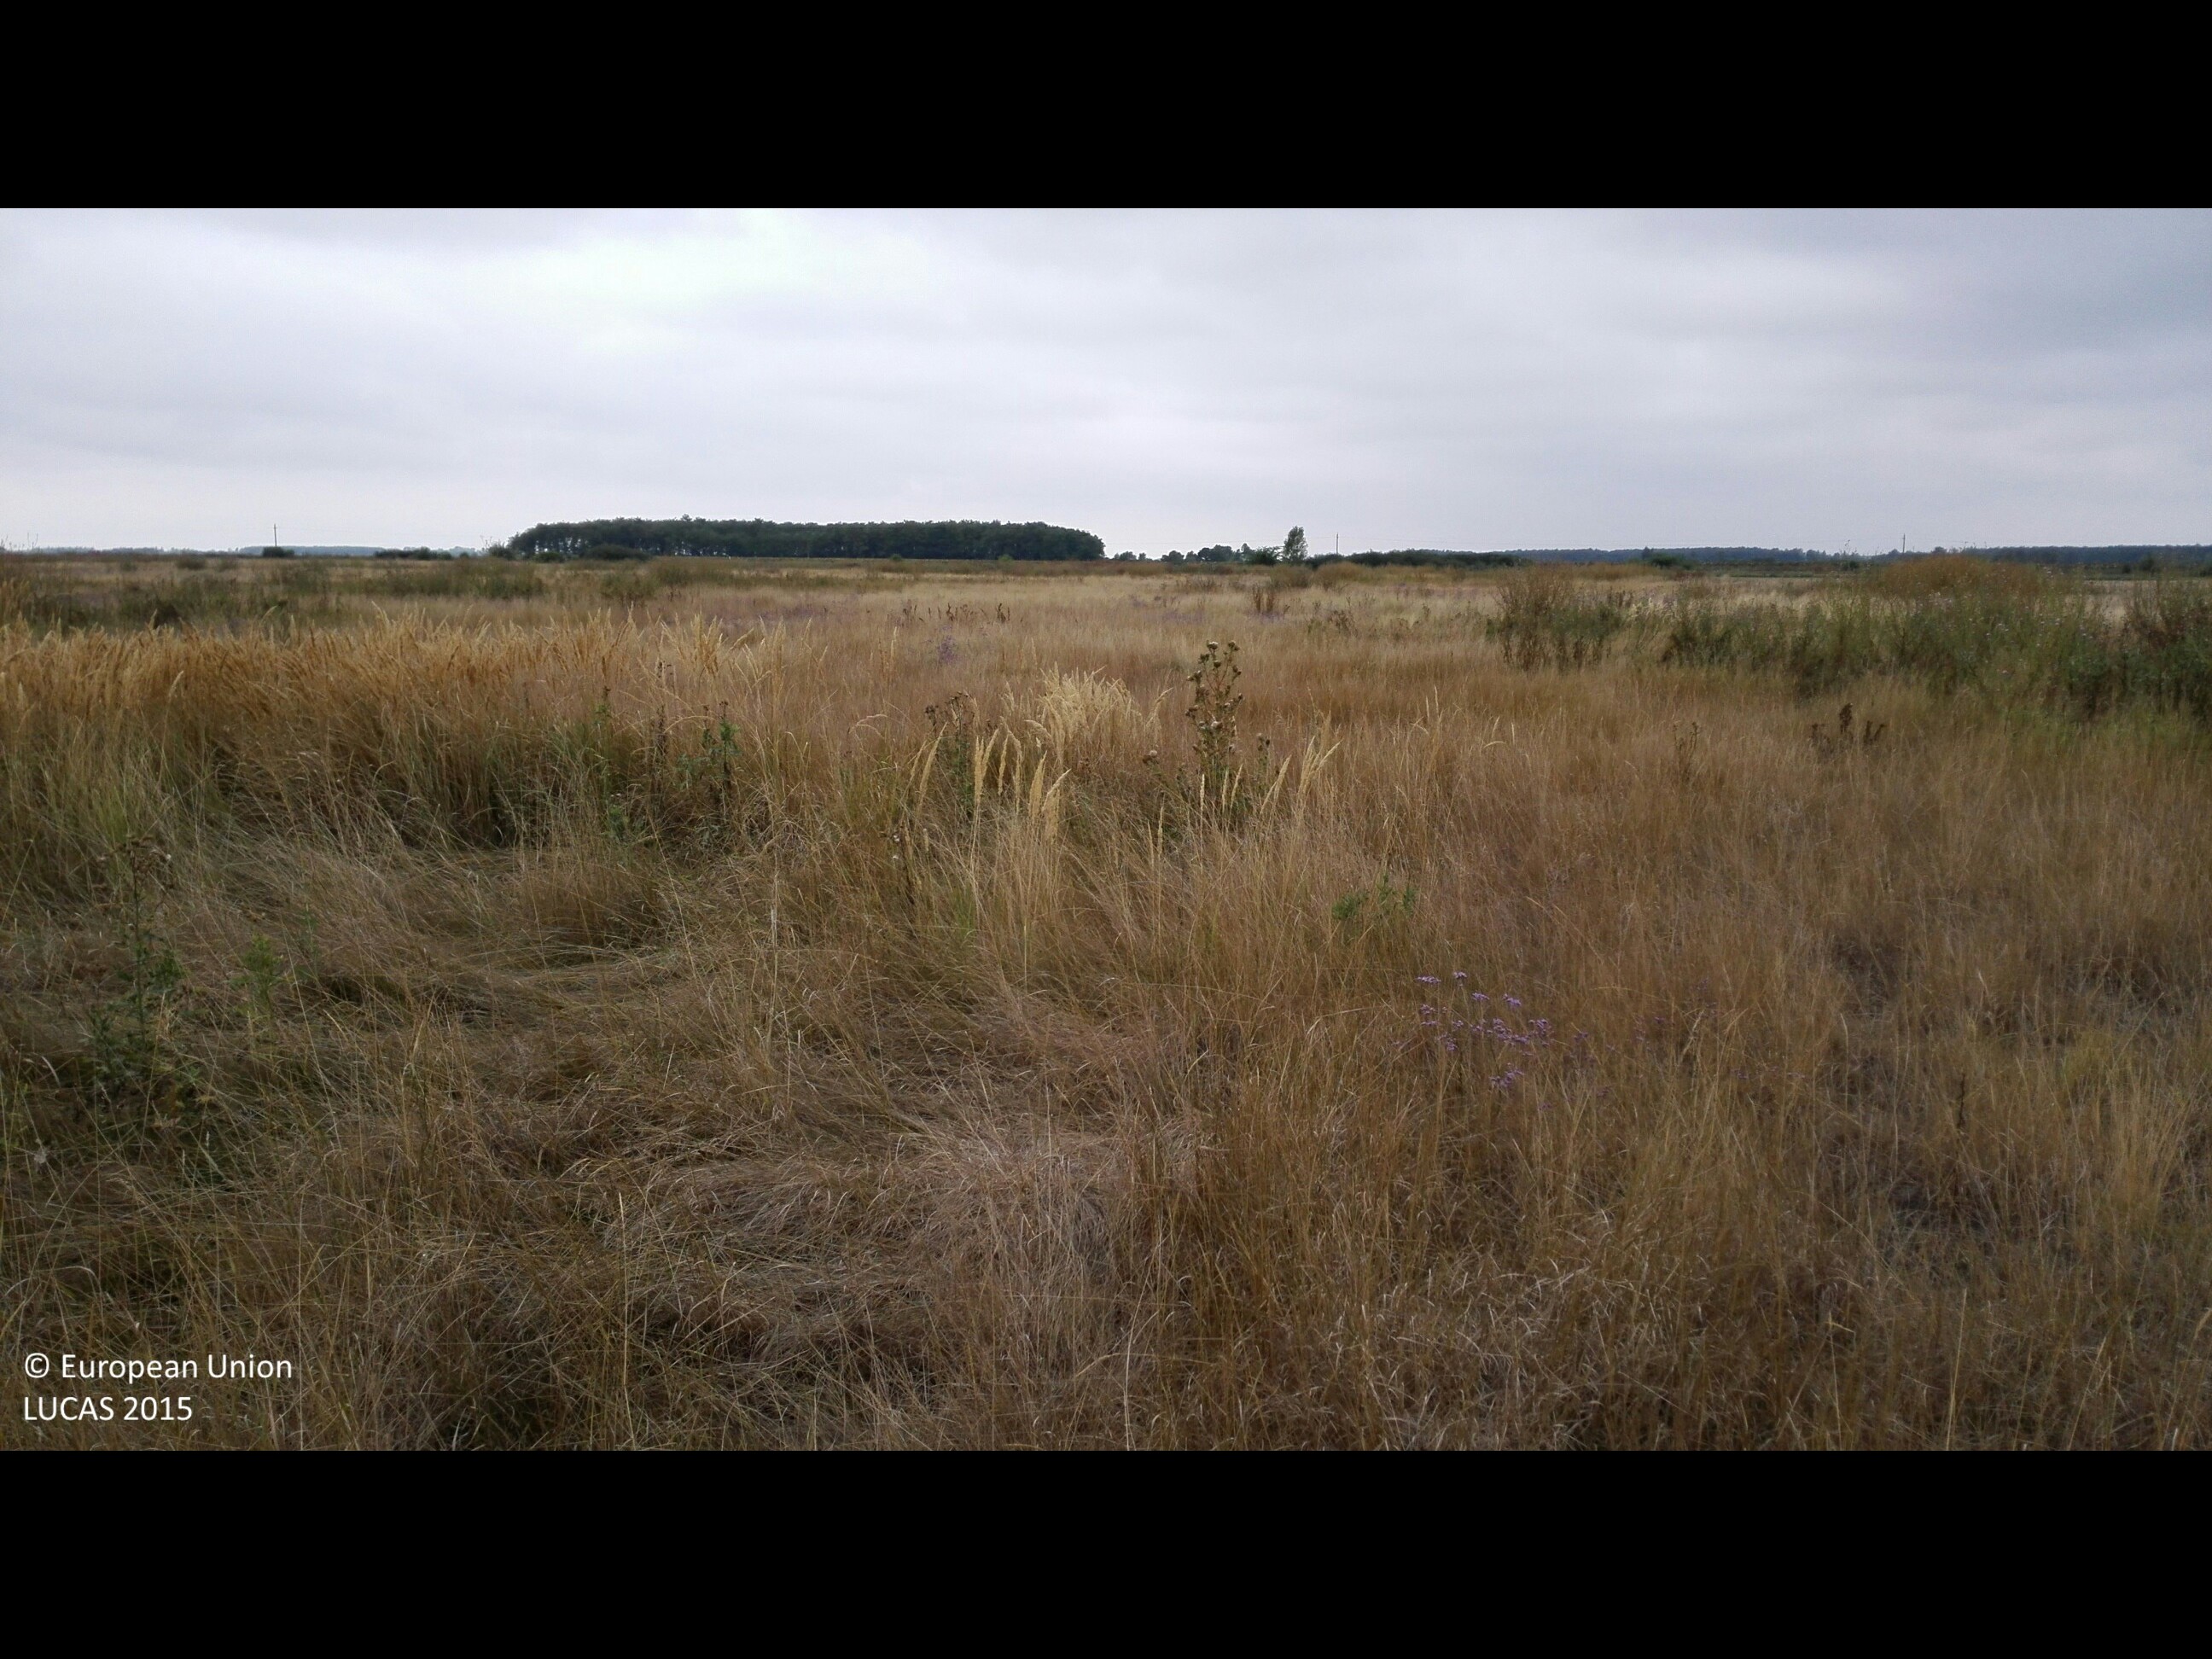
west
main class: Grassland
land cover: Grassland without tree/shrub cover
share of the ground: > 75 %
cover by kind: herbaceous plants 100 %
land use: Semi-natural and natural areas not in use
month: August
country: HU
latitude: 47.2223
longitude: 21.8120
